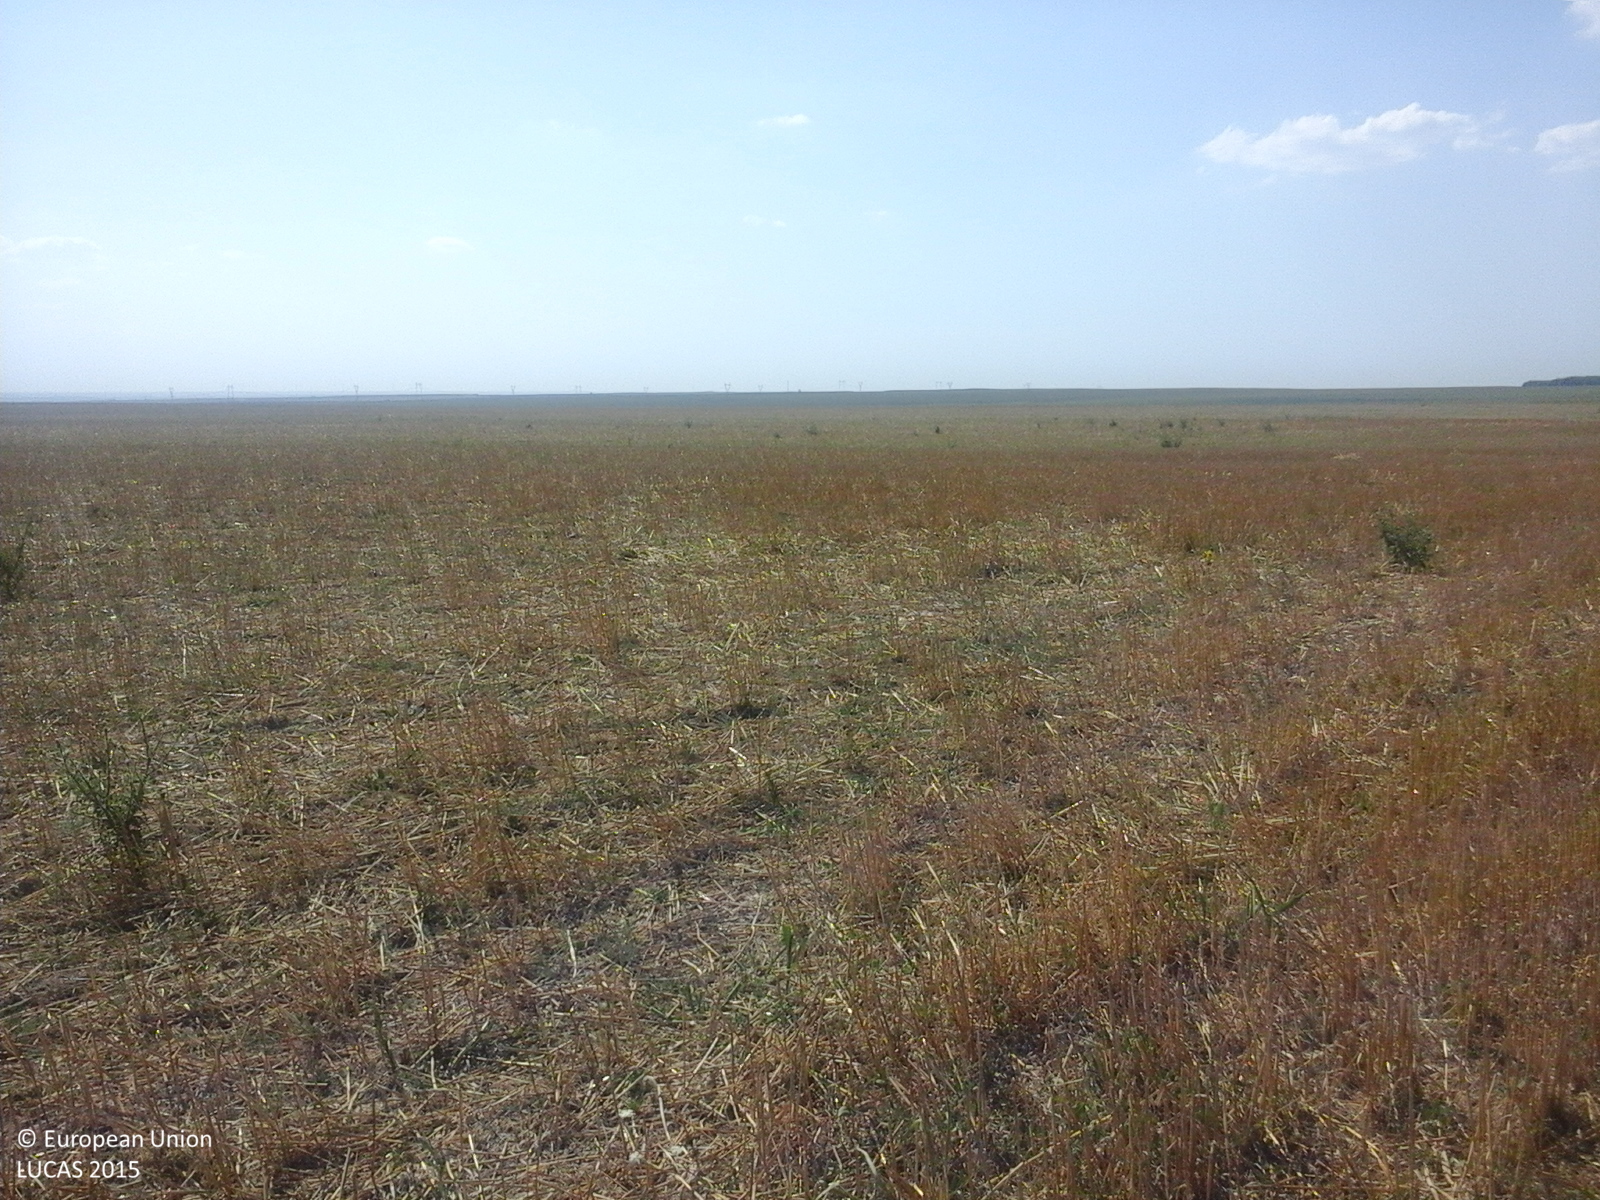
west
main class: Cropland
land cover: Barley
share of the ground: > 75 %
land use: Agriculture (excluding fallow land and kitchen gardens)
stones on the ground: < 10 %
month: August
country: RO
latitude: 44.5636
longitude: 28.1295
